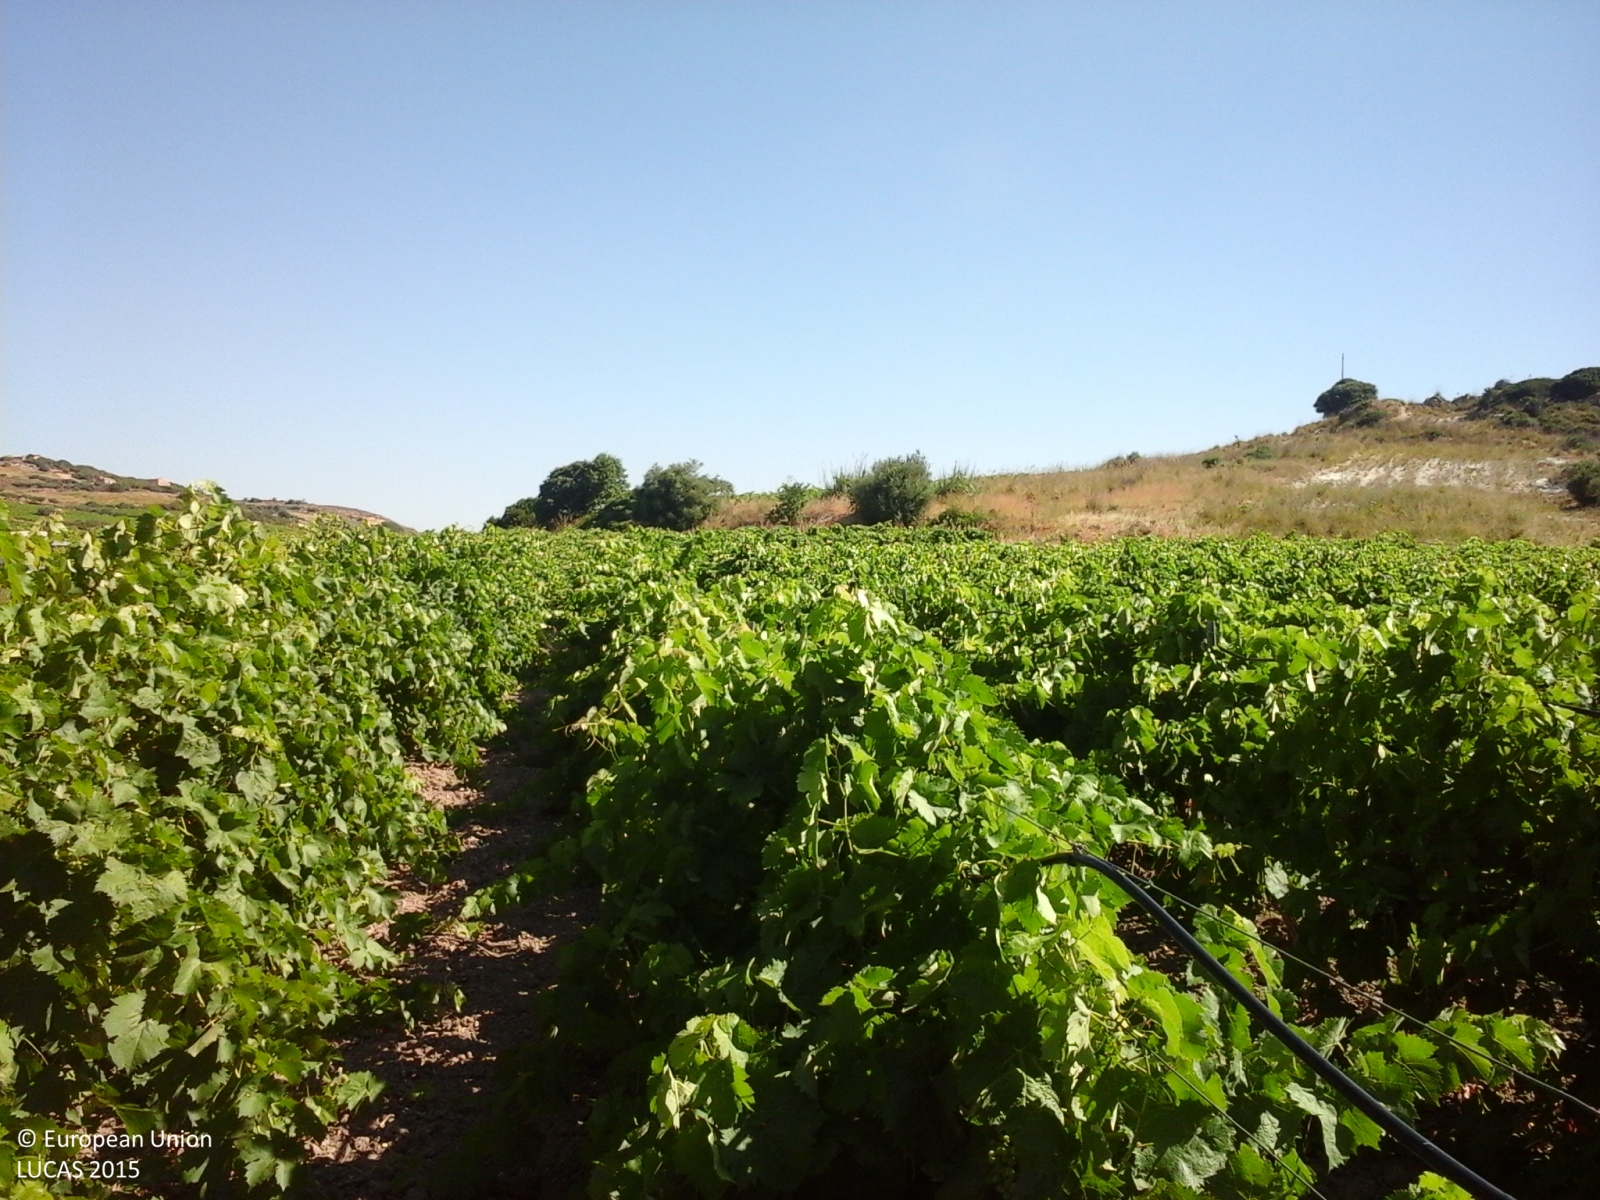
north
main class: Cropland
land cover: Vineyards
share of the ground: 50 - 75 %
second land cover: Other bare soil
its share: > 75 %
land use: Agriculture (excluding fallow land and kitchen gardens)
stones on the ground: < 10 %
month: June
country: IT
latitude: 37.7101
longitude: 12.6683
